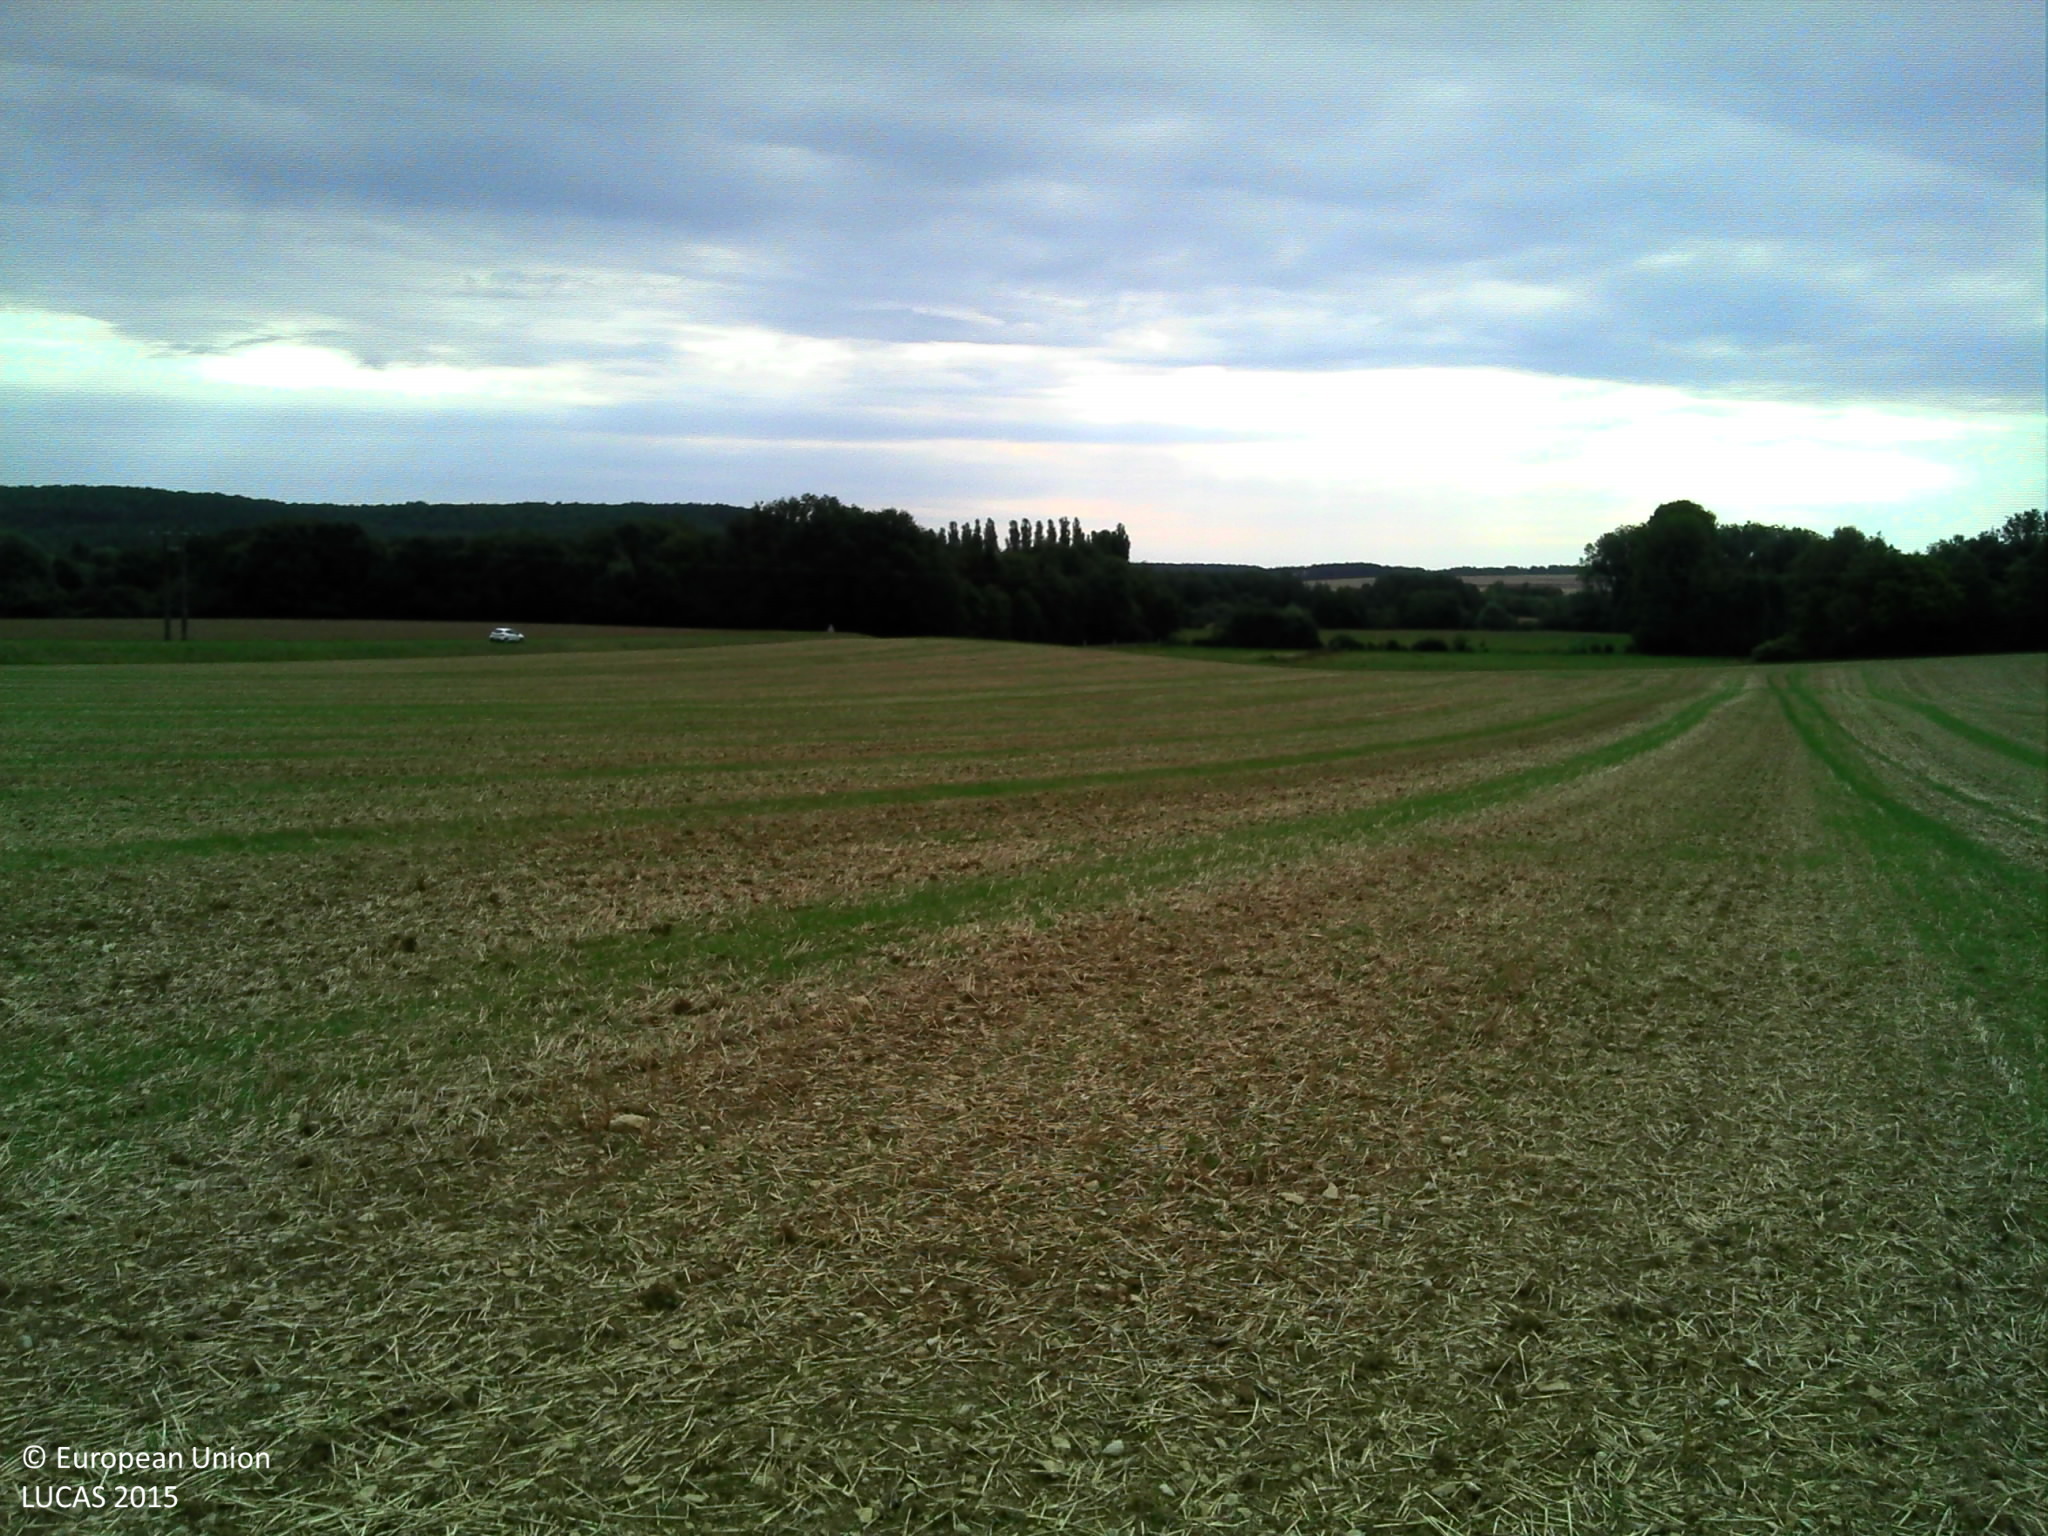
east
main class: Cropland
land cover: Common wheat
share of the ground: 10 - 25 %
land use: Agriculture (excluding fallow land and kitchen gardens)
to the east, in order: Common wheat; Electric lines; Common wheat
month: August
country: FR
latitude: 47.8798
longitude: 4.3417
